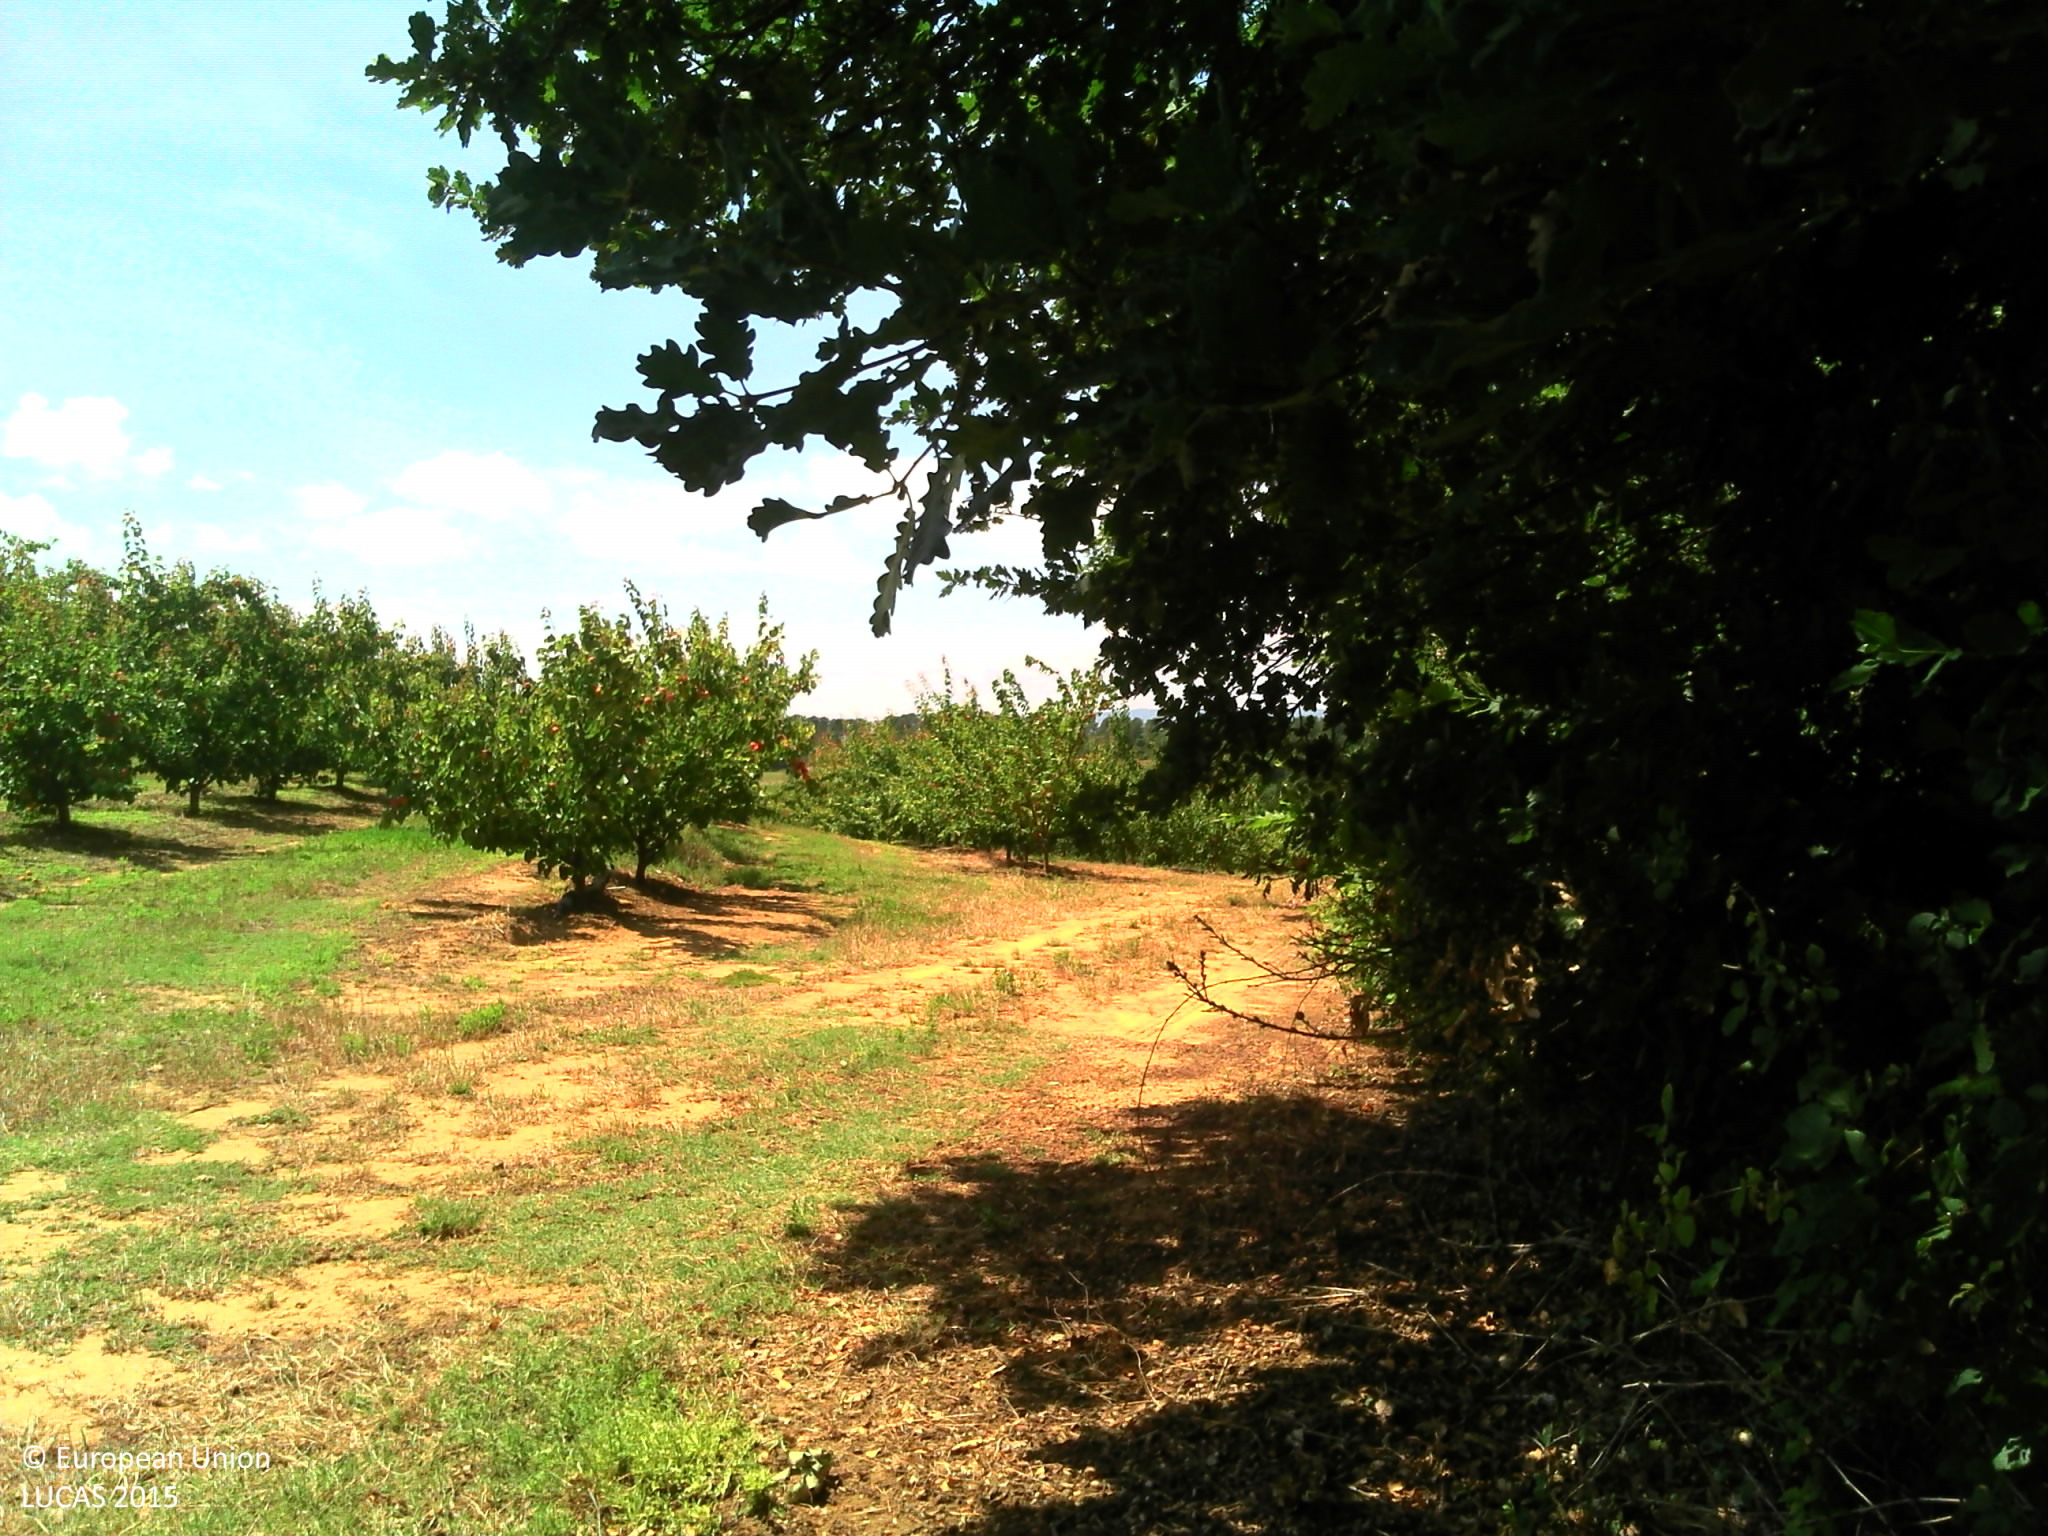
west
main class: Woodland
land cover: Broadleaved woodland
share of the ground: > 75 %
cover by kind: broadleaved forest trees 95 %, herbaceous plants 5 %
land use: Semi-natural and natural areas not in use
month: June
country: FR
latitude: 44.8410
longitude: 4.9330
